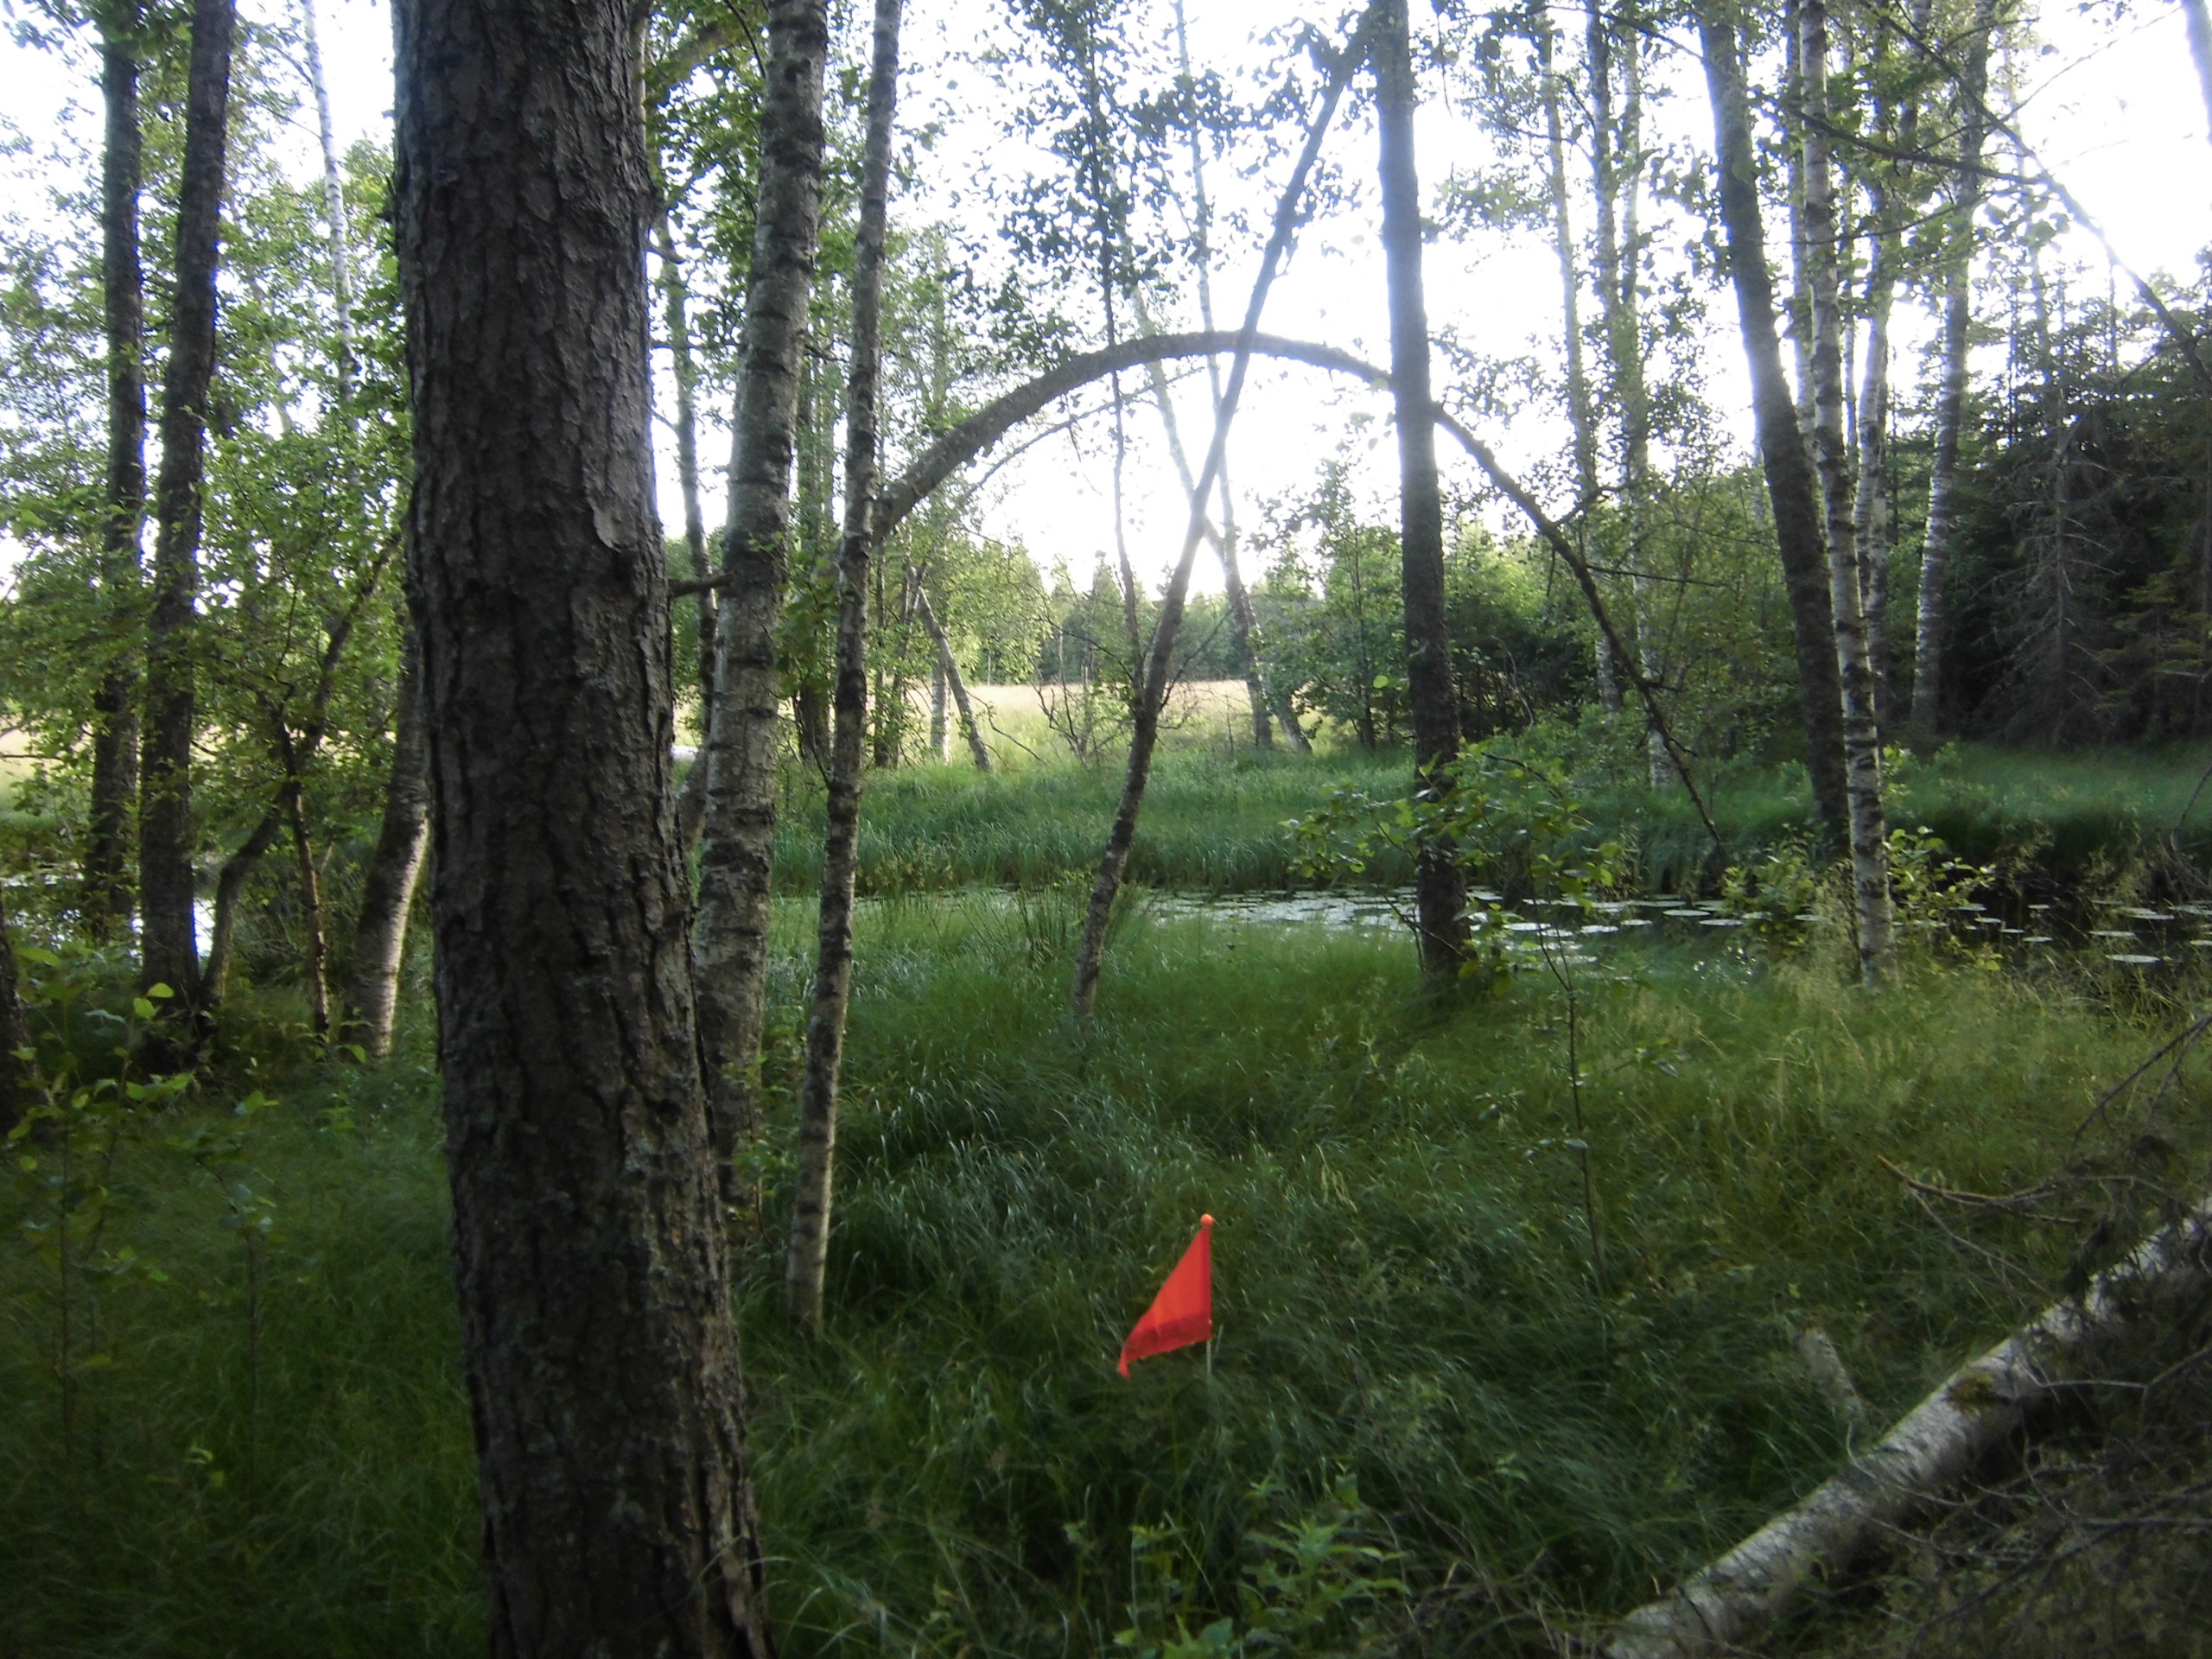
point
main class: Woodland
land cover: Pine dominated mixed woodland
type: boreal forest
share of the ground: 50 - 75 %
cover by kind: broadleaved forest trees 35 %, herbaceous plants 35 %, coniferous forest trees 25 %, shrubs 5 %
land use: Forestry
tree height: > 5 m
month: July
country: SE
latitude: 57.2464
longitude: 15.3832
